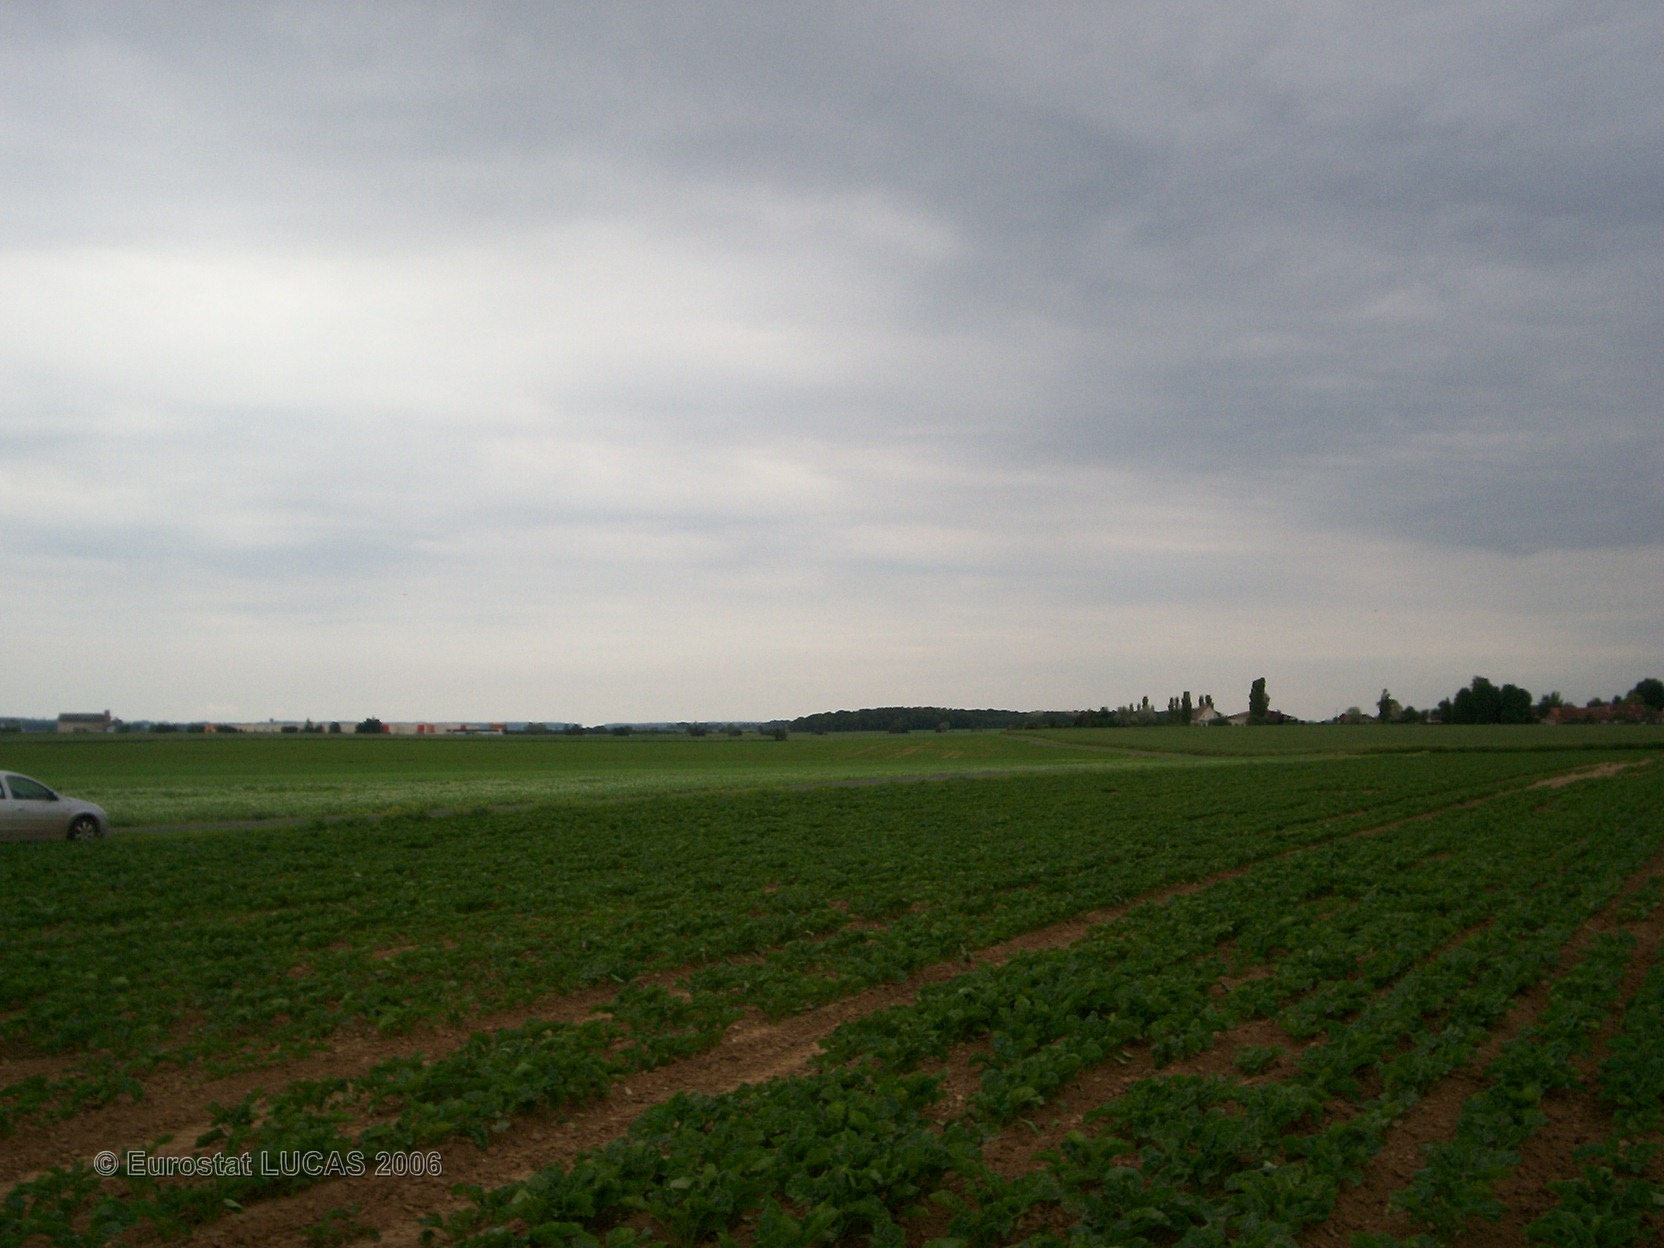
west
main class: Cropland
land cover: Sugar beet
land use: Agriculture (excluding fallow land and kitchen gardens)
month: June
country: FR
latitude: 49.4422
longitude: 2.6655
